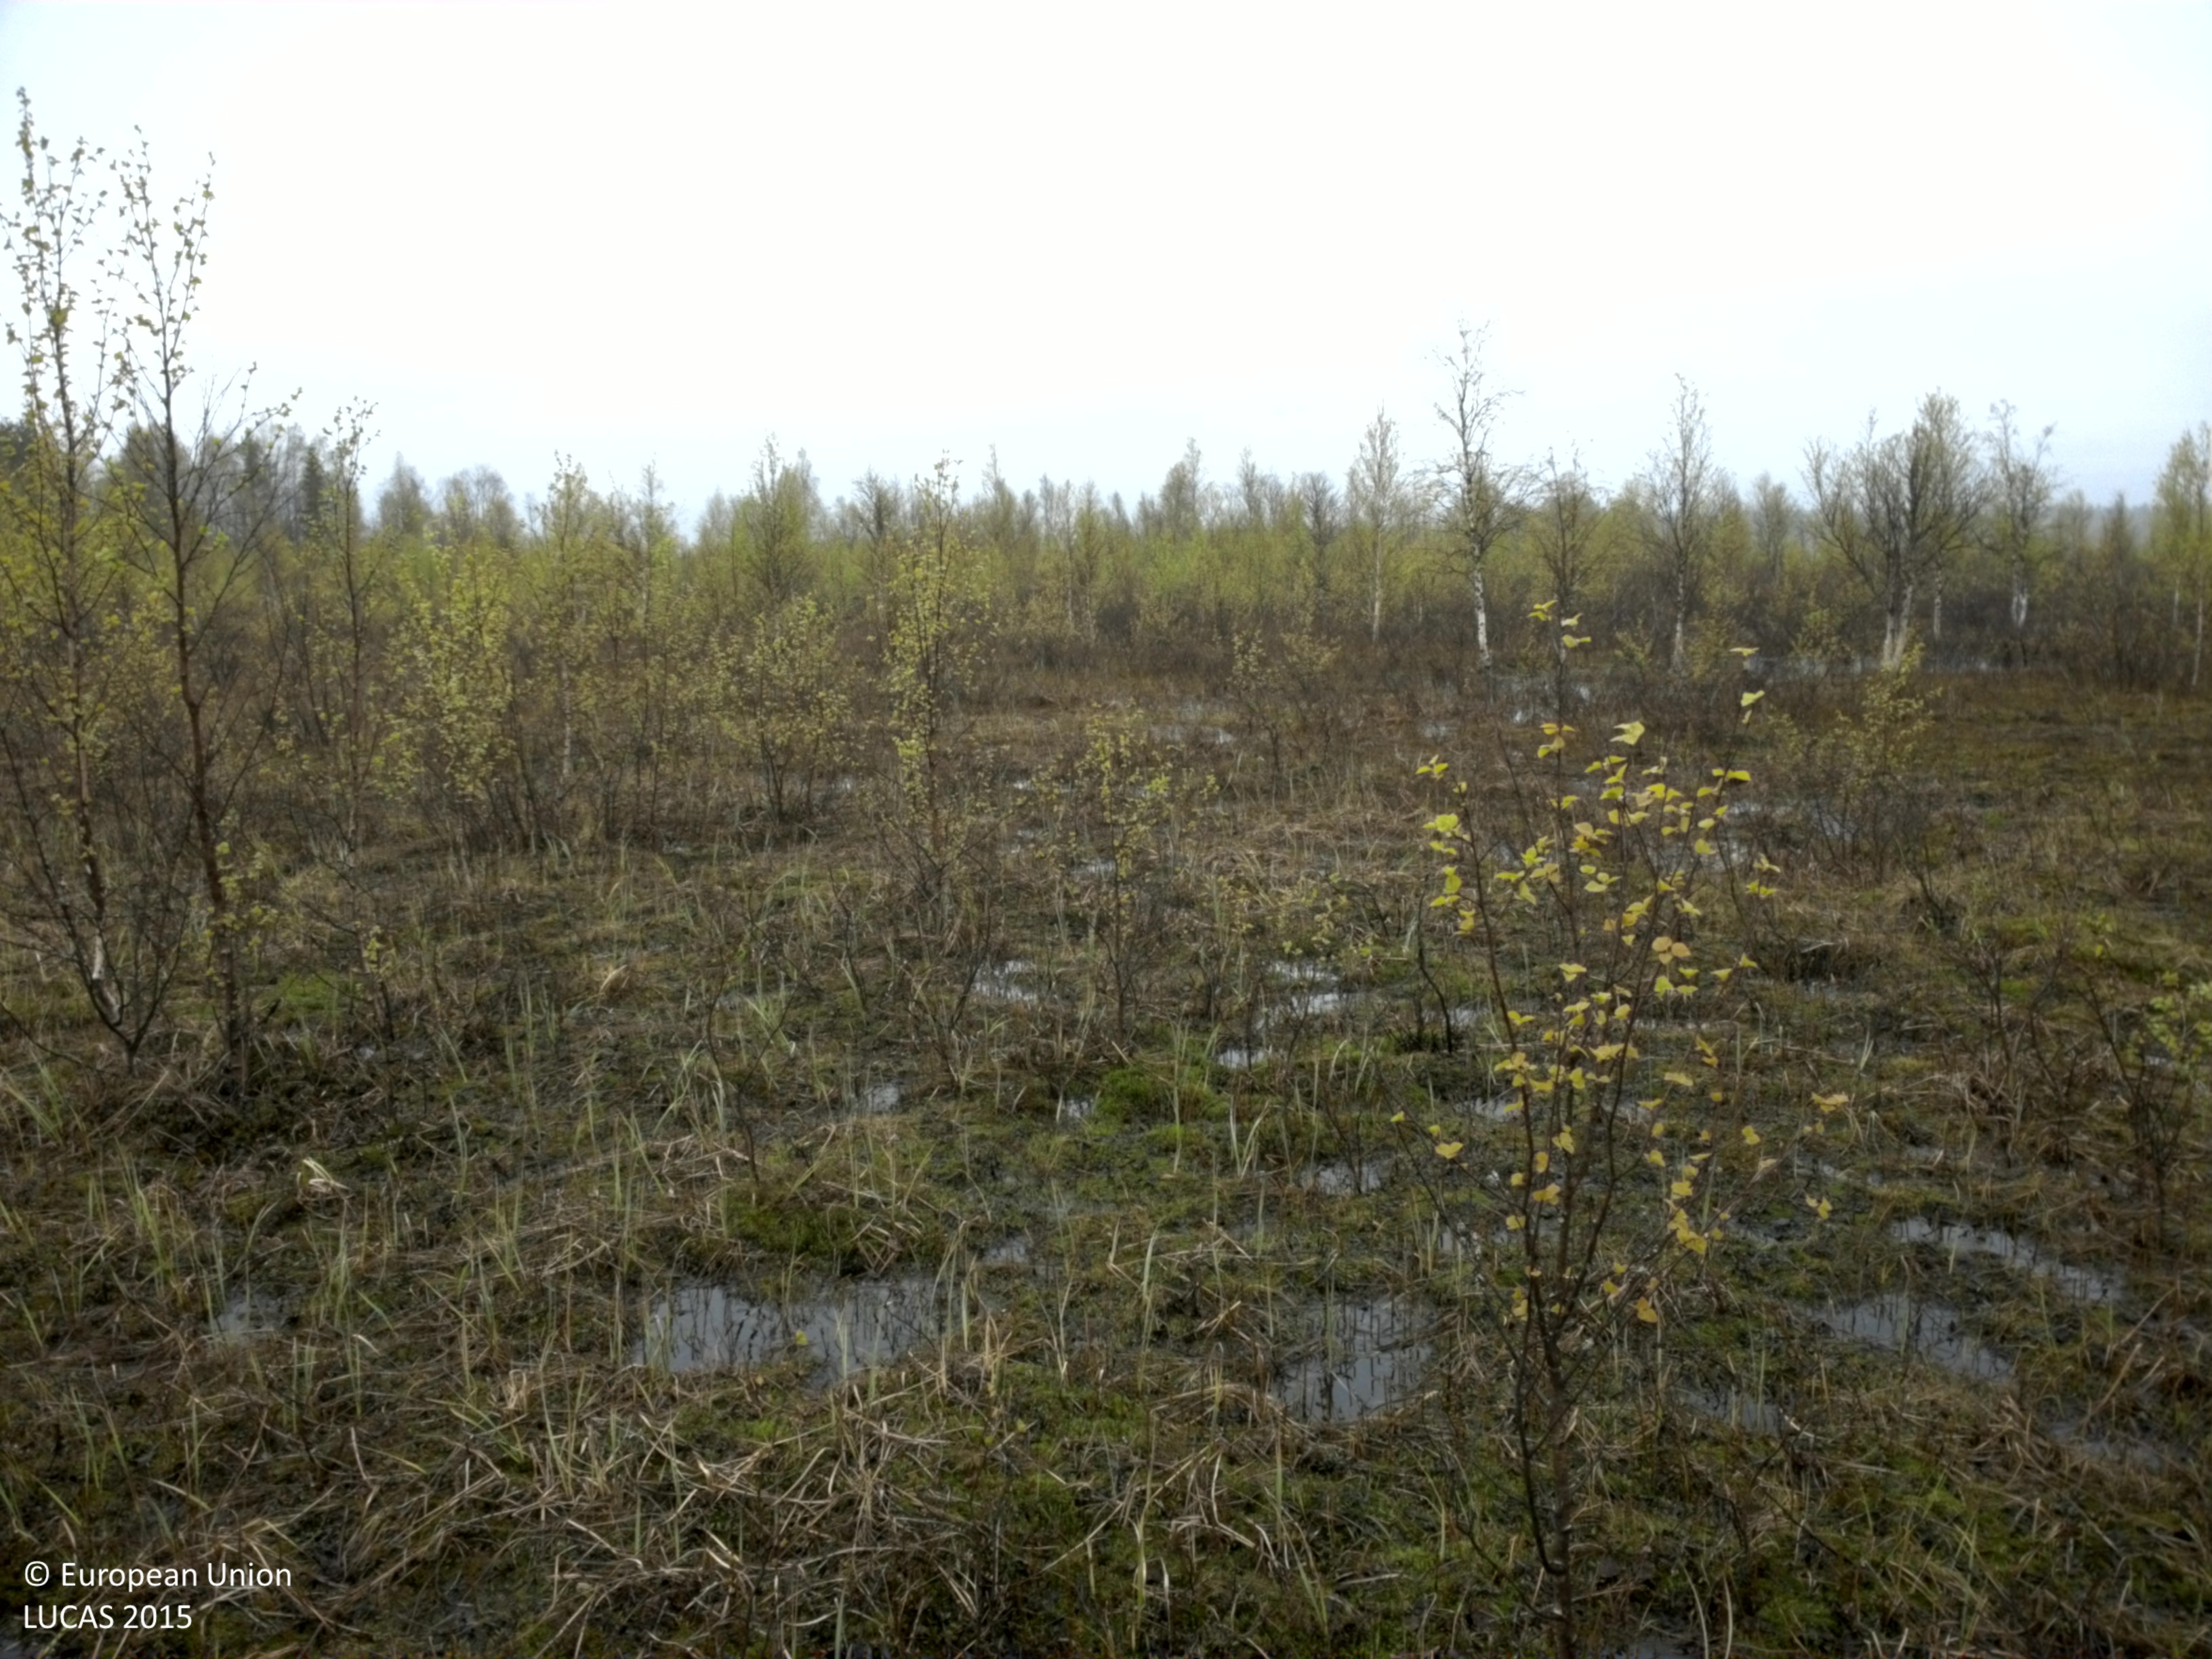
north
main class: Woodland
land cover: Broadleaved woodland
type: mire and swamp forests
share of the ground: 50 - 75 %
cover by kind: broadleaved forest trees 50 %, lichens and mosses 40 %, herbaceous plants 10 %
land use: Semi-natural and natural areas not in use
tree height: < 5 m
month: June
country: SE
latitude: 65.9253
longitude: 23.1466
